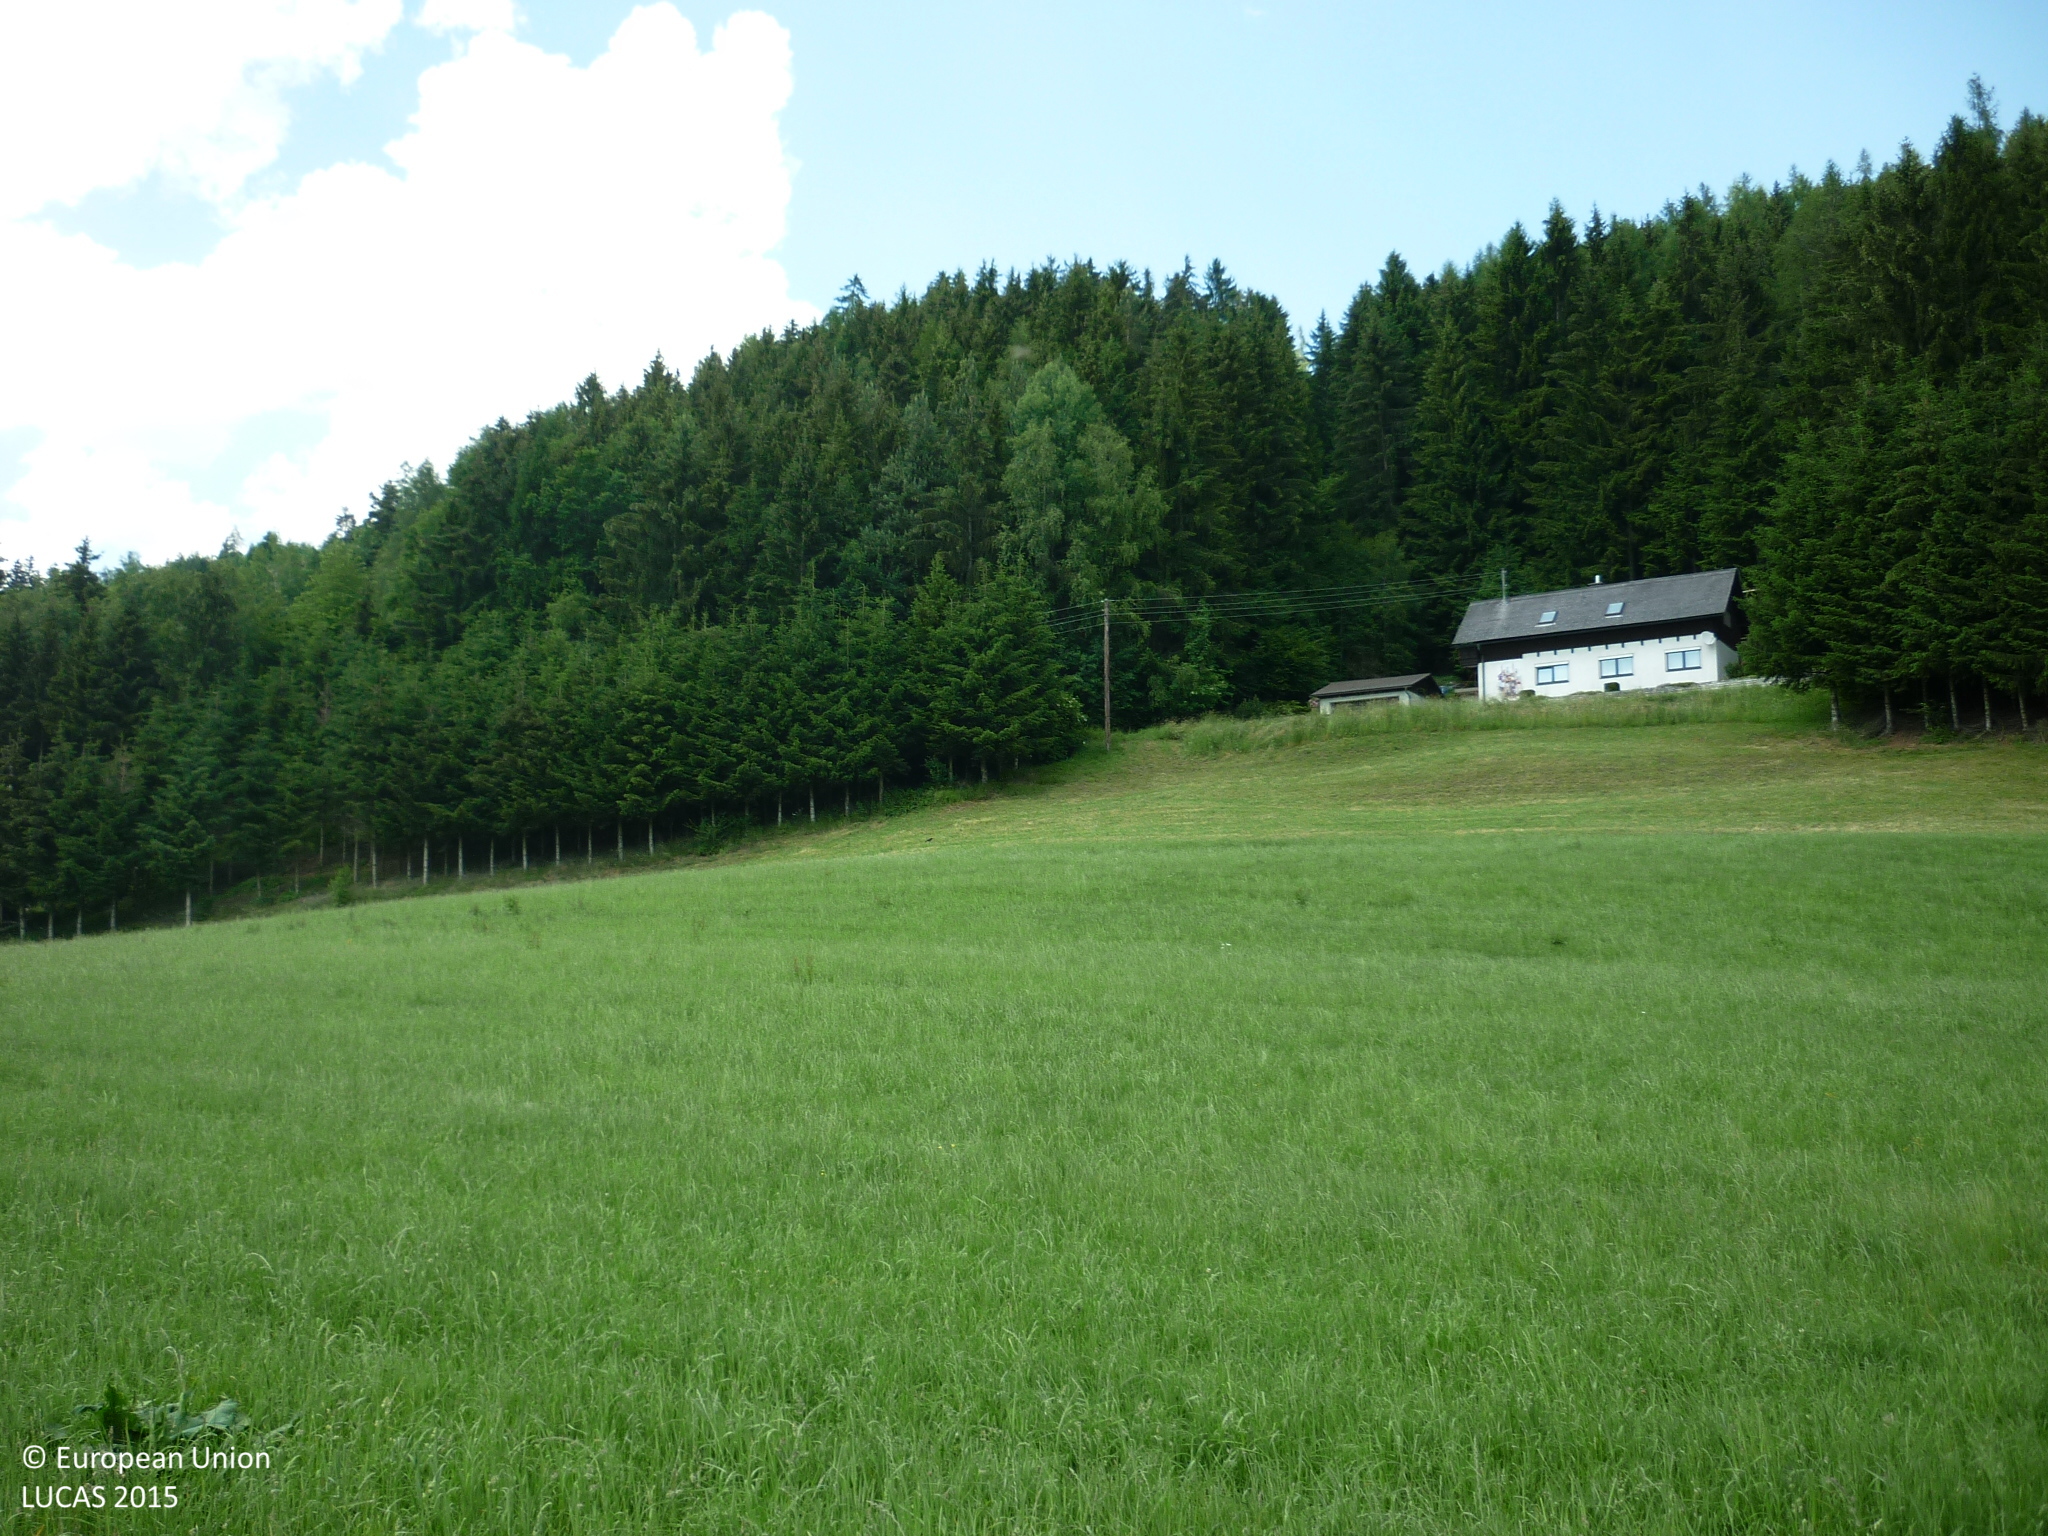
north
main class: Grassland
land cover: Grassland without tree/shrub cover
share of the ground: > 75 %
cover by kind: herbaceous plants 100 %
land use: Agriculture (excluding fallow land and kitchen gardens)
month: June
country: AT
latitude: 47.2068
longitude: 14.6327
